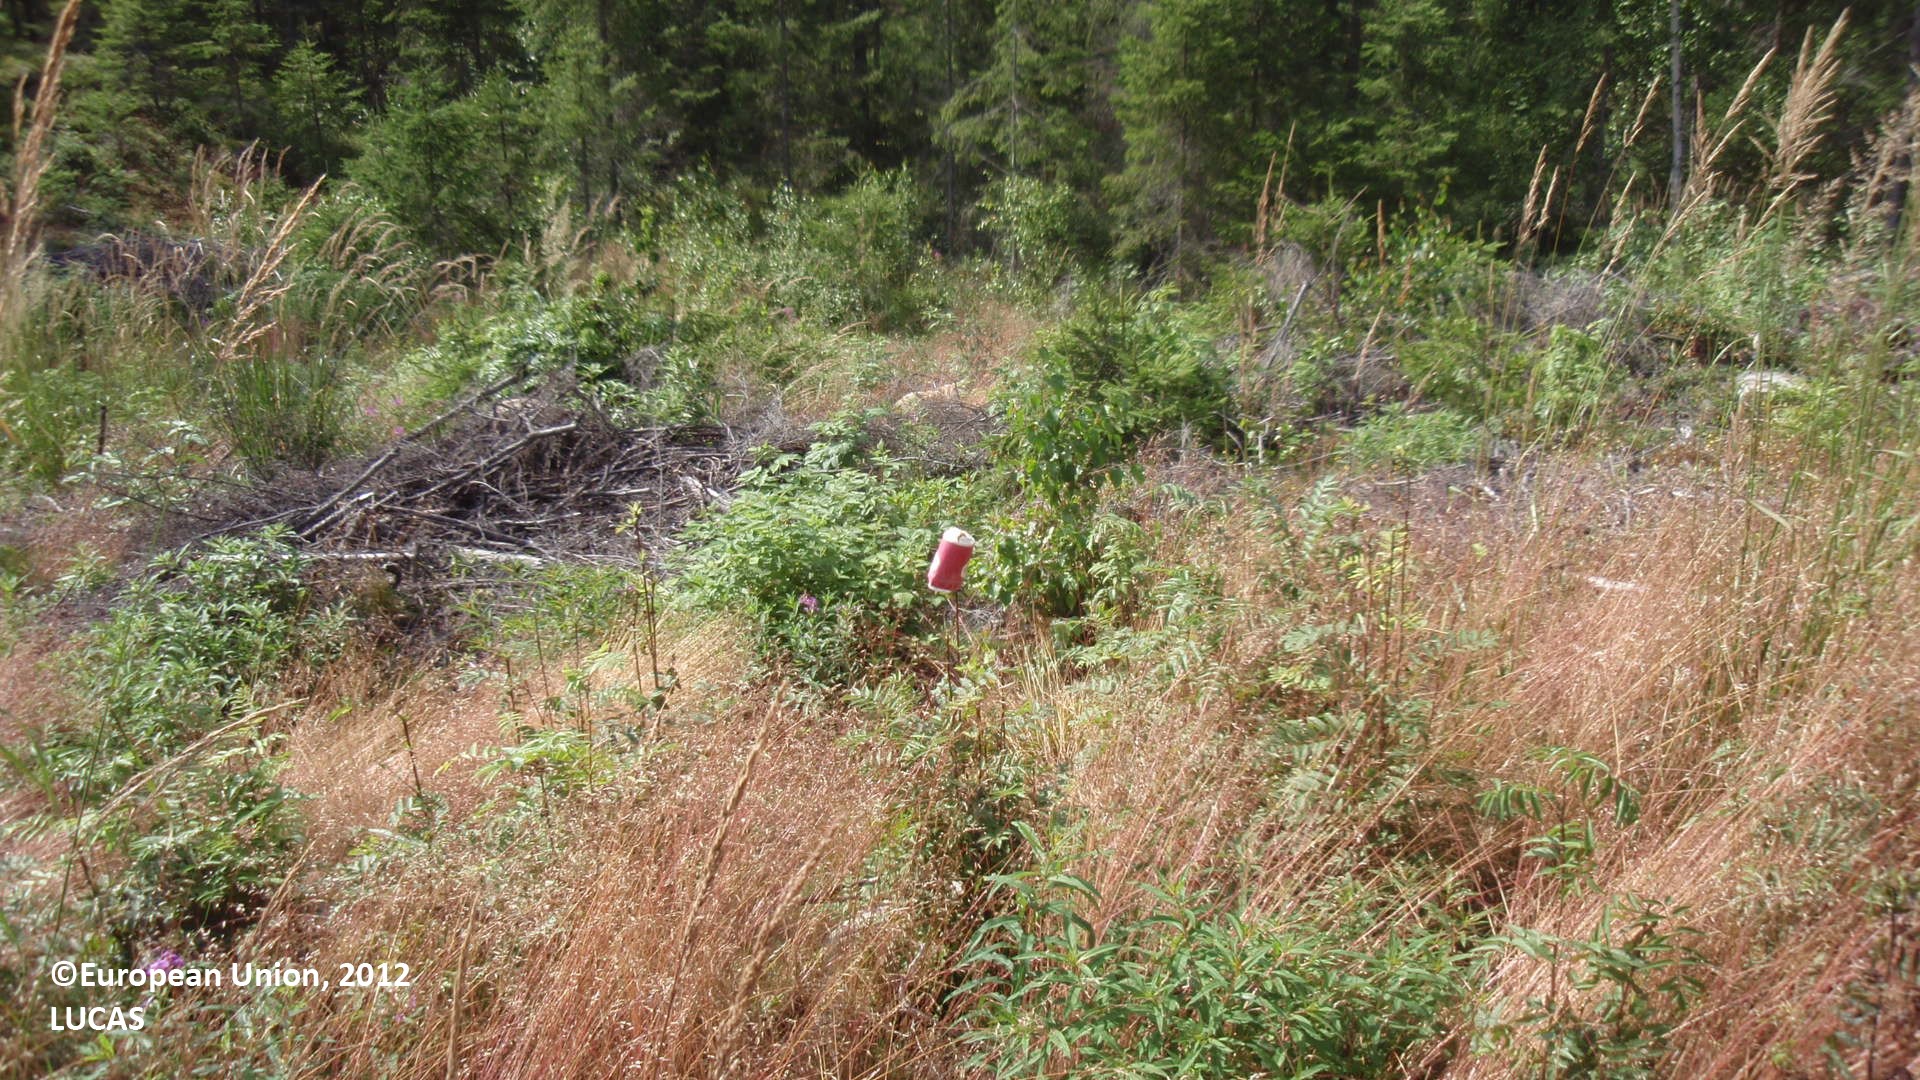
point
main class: Woodland
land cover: Spruce dominated mixed woodland
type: boreal forest
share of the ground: 10 - 25 %
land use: Forestry
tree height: < 5 m
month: July
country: FI
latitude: 61.4723
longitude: 28.7474
